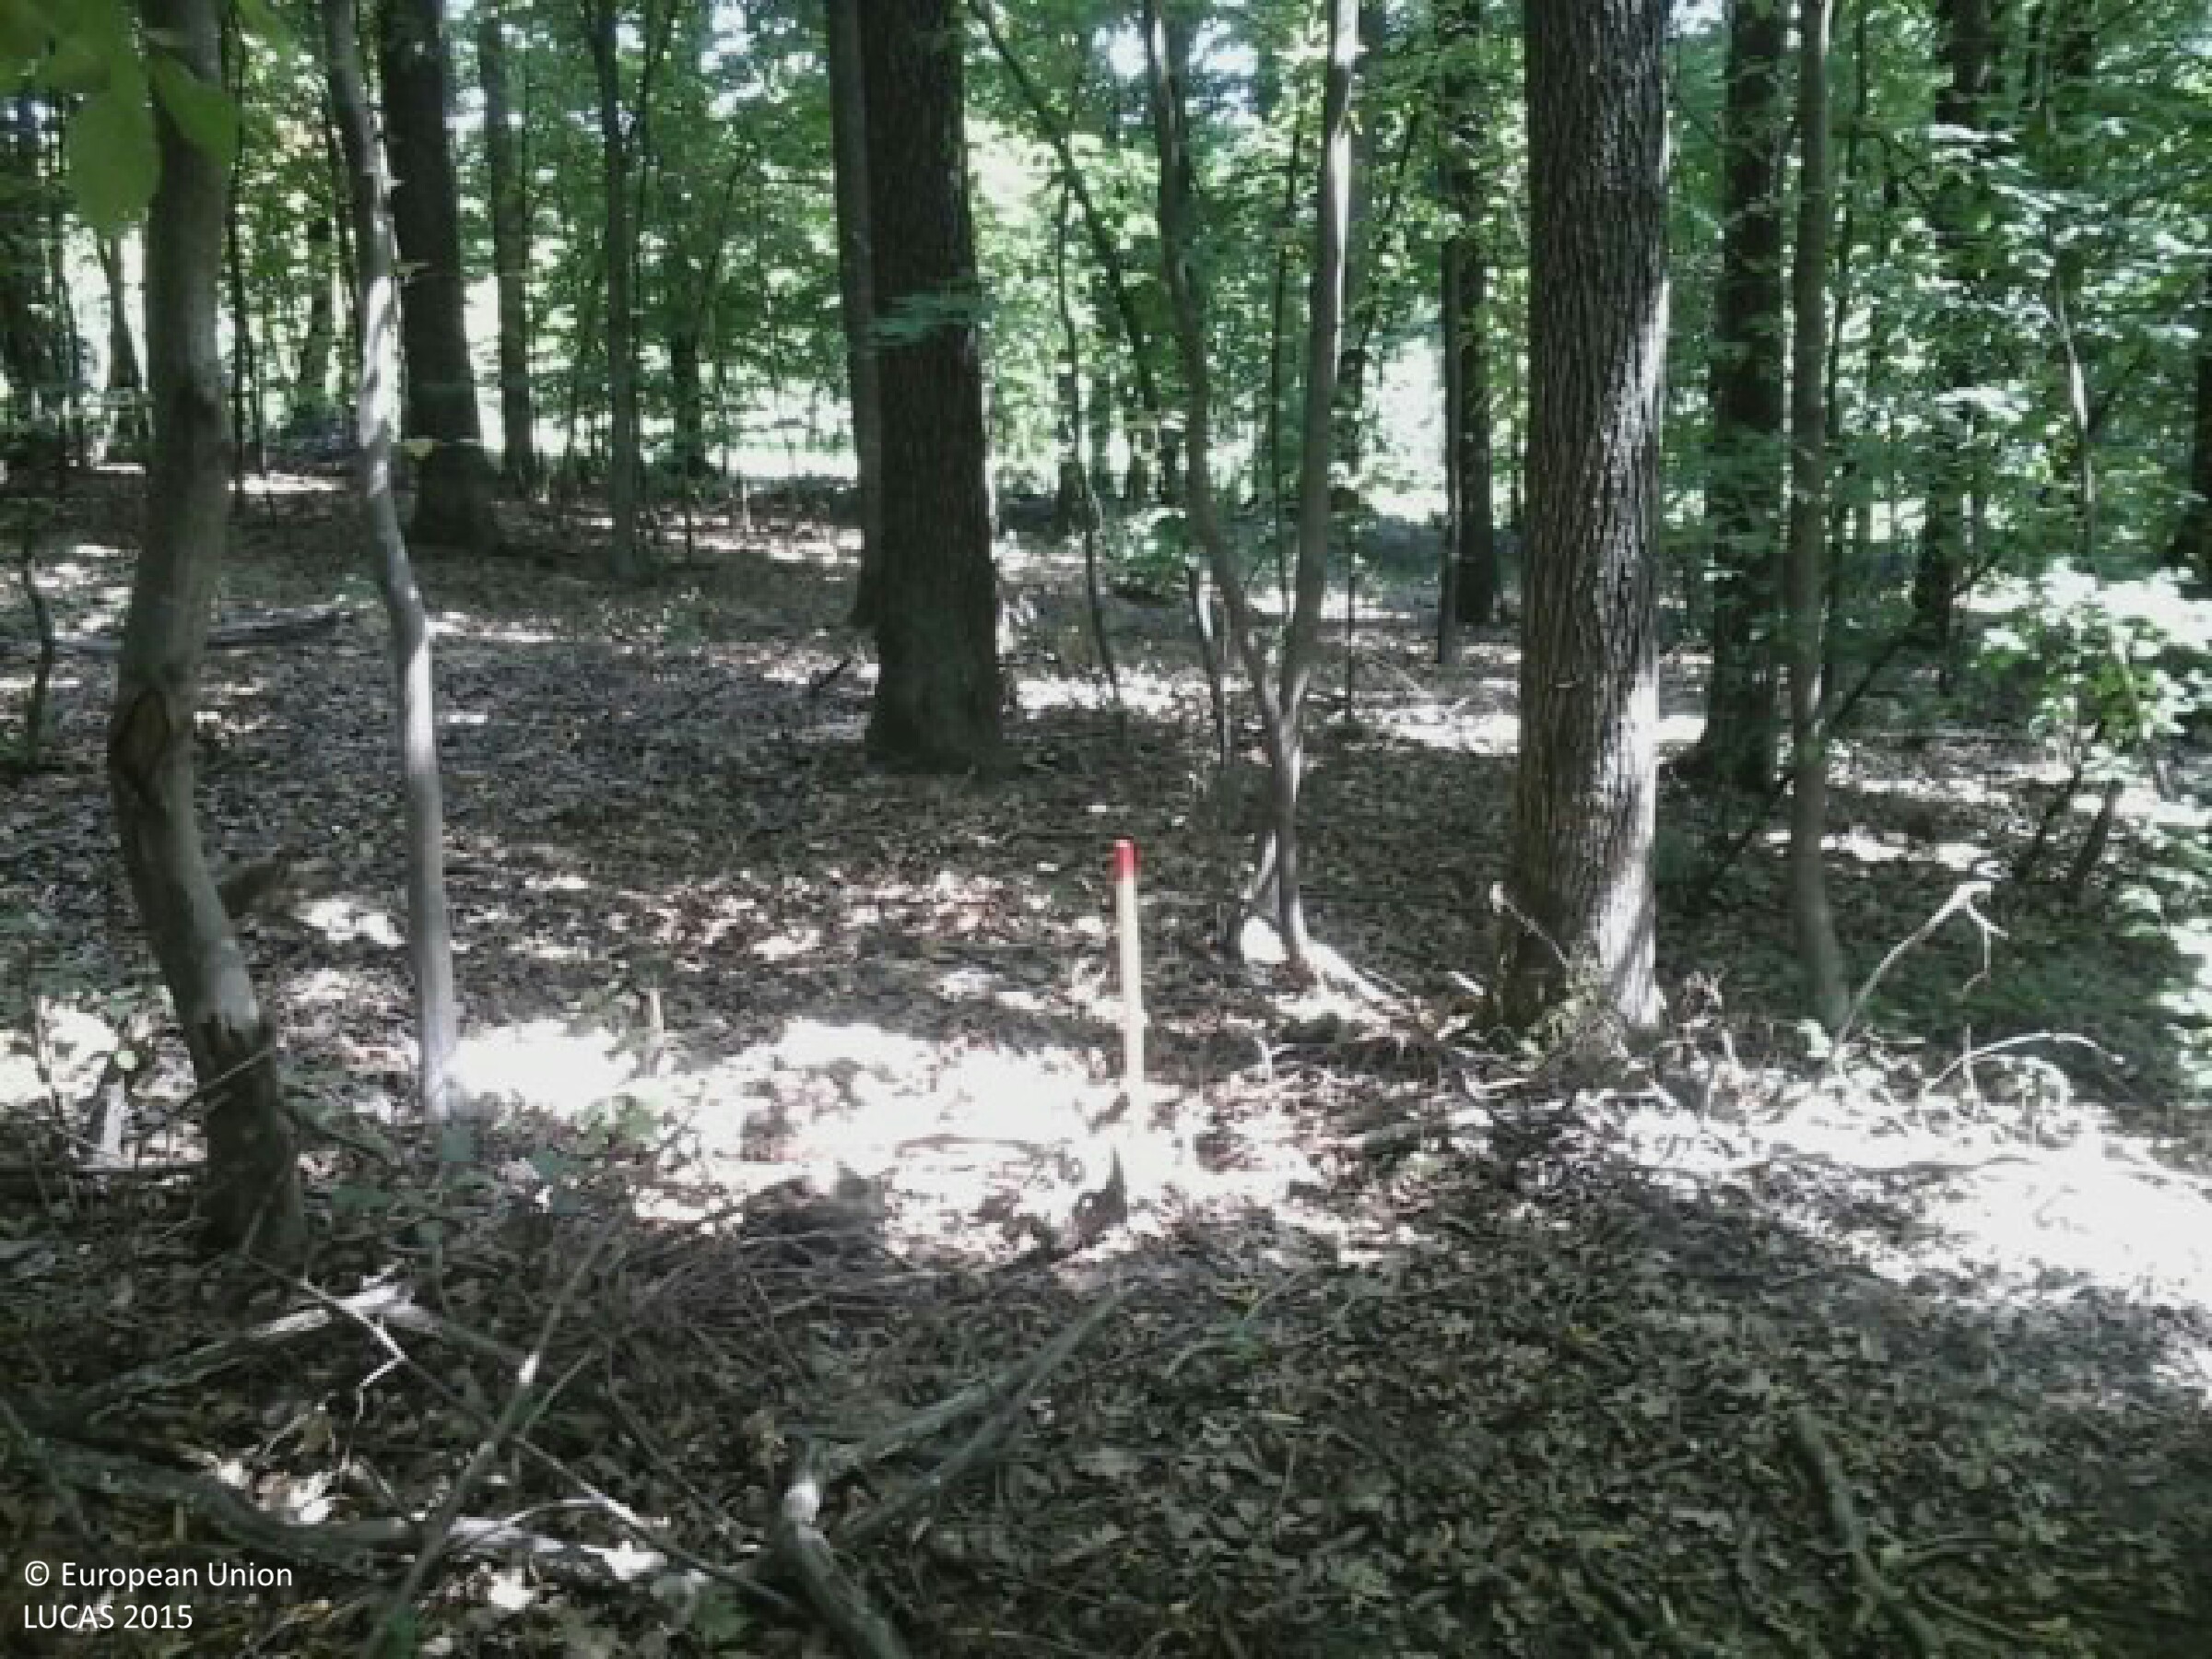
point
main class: Woodland
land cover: Broadleaved woodland
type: mesophytic deciduous forest
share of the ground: > 75 %
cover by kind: broadleaved forest trees 90 %, herbaceous plants 5 %, unconsolidated bare surface 5 %
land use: Forestry
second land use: Amenities, museums, leisure
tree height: > 5 m
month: August
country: HU
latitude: 46.4442
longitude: 17.0450
